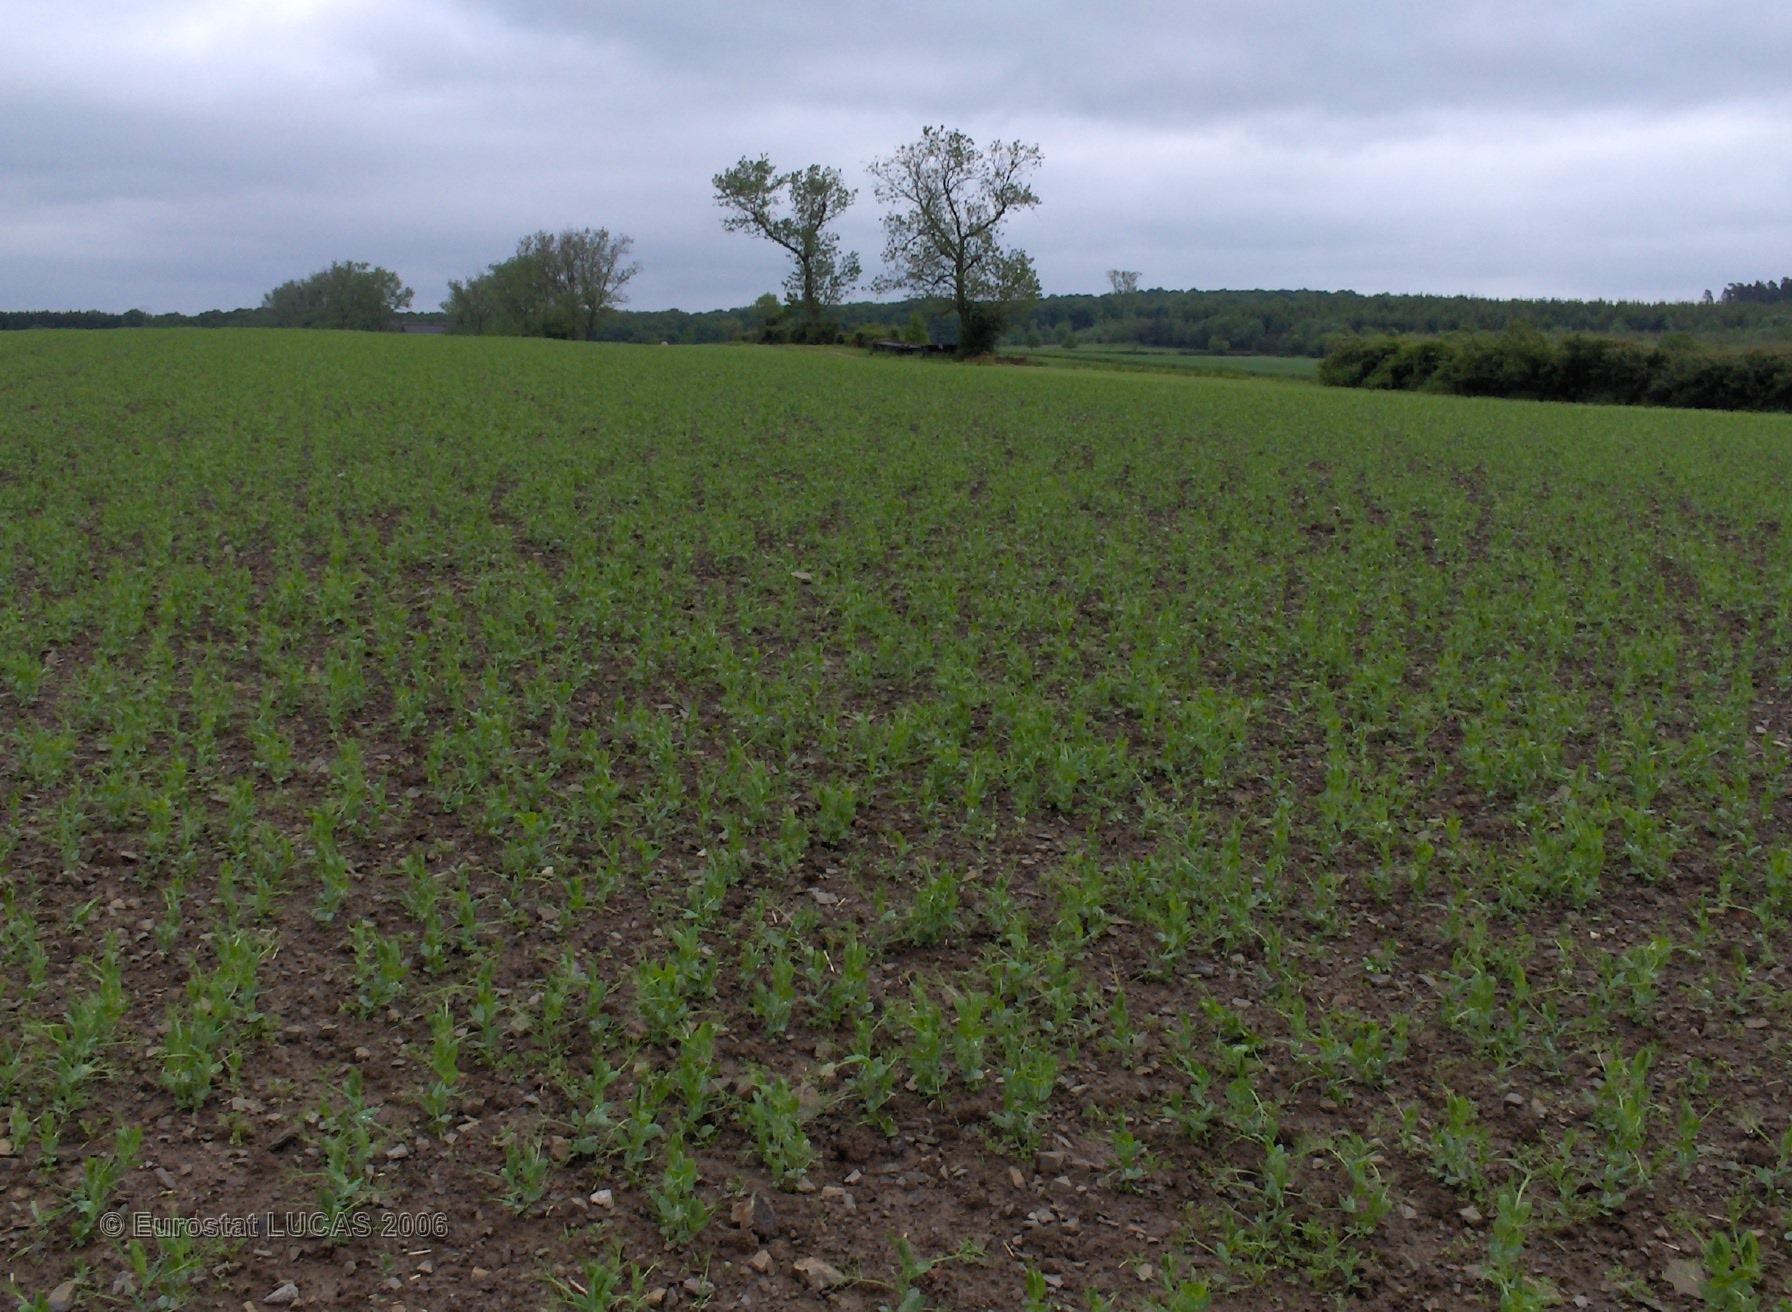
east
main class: Cropland
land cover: Dry pulses
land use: Agriculture (excluding fallow land and kitchen gardens)
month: June
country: BE
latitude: 50.1276
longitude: 4.5827
